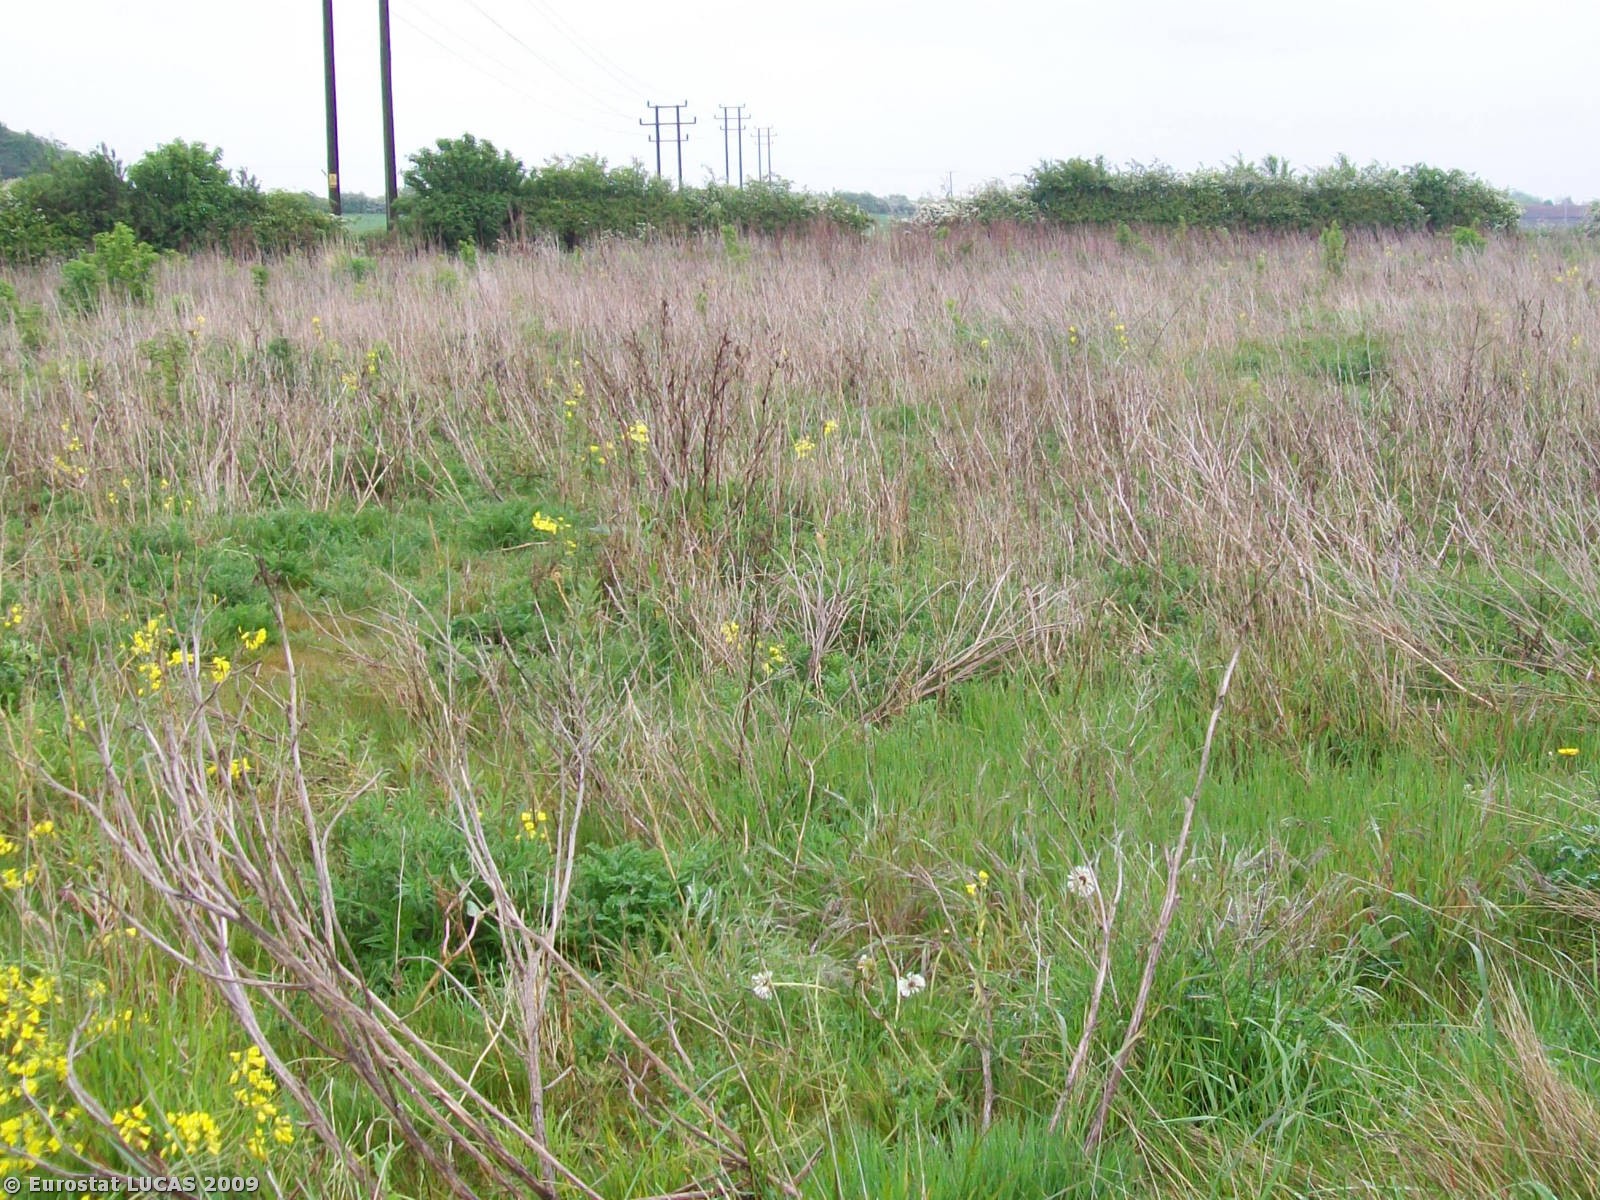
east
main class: Grassland
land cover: Grassland with sparse tree/shrub cover
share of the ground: 25 - 50 %
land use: Agriculture (excluding fallow land and kitchen gardens)
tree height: > 5 m
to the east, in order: Grassland with sparse tree/shrub cover; Managed hedges; Ditches and canals; Grass margins; Rape and turnip rape; Grass margins; Managed hedges
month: May
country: GB
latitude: 52.9631
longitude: -0.8958
